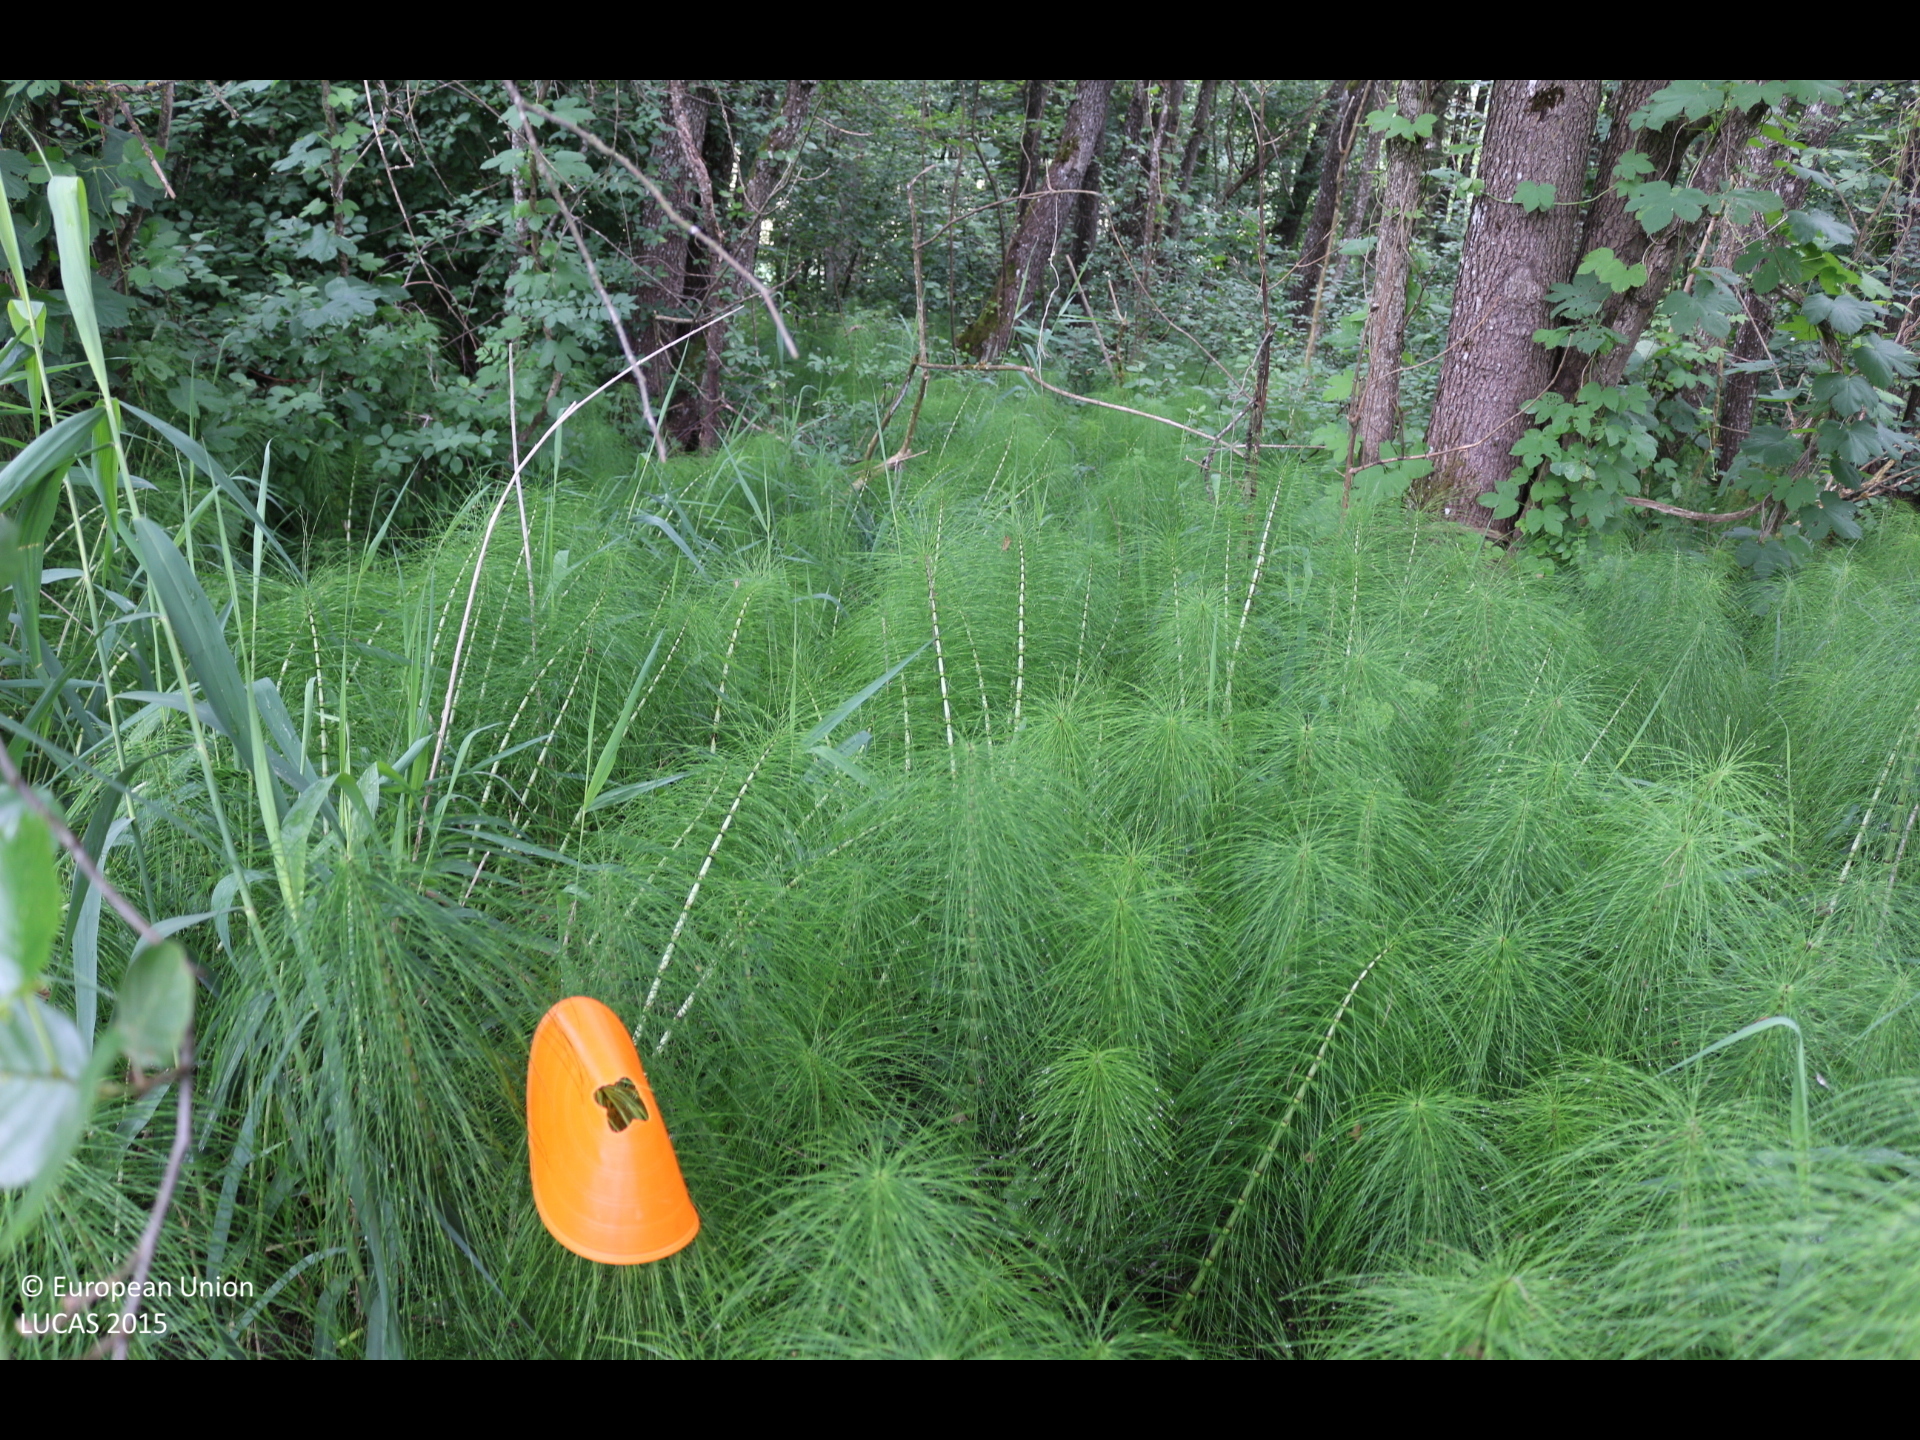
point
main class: Woodland
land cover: Broadleaved woodland
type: floodplain forest
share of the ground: > 75 %
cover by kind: broadleaved forest trees 100 %
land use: Forestry
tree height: > 5 m
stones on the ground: 10 - 25 %
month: June
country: AT
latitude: 46.7145
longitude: 14.3277
